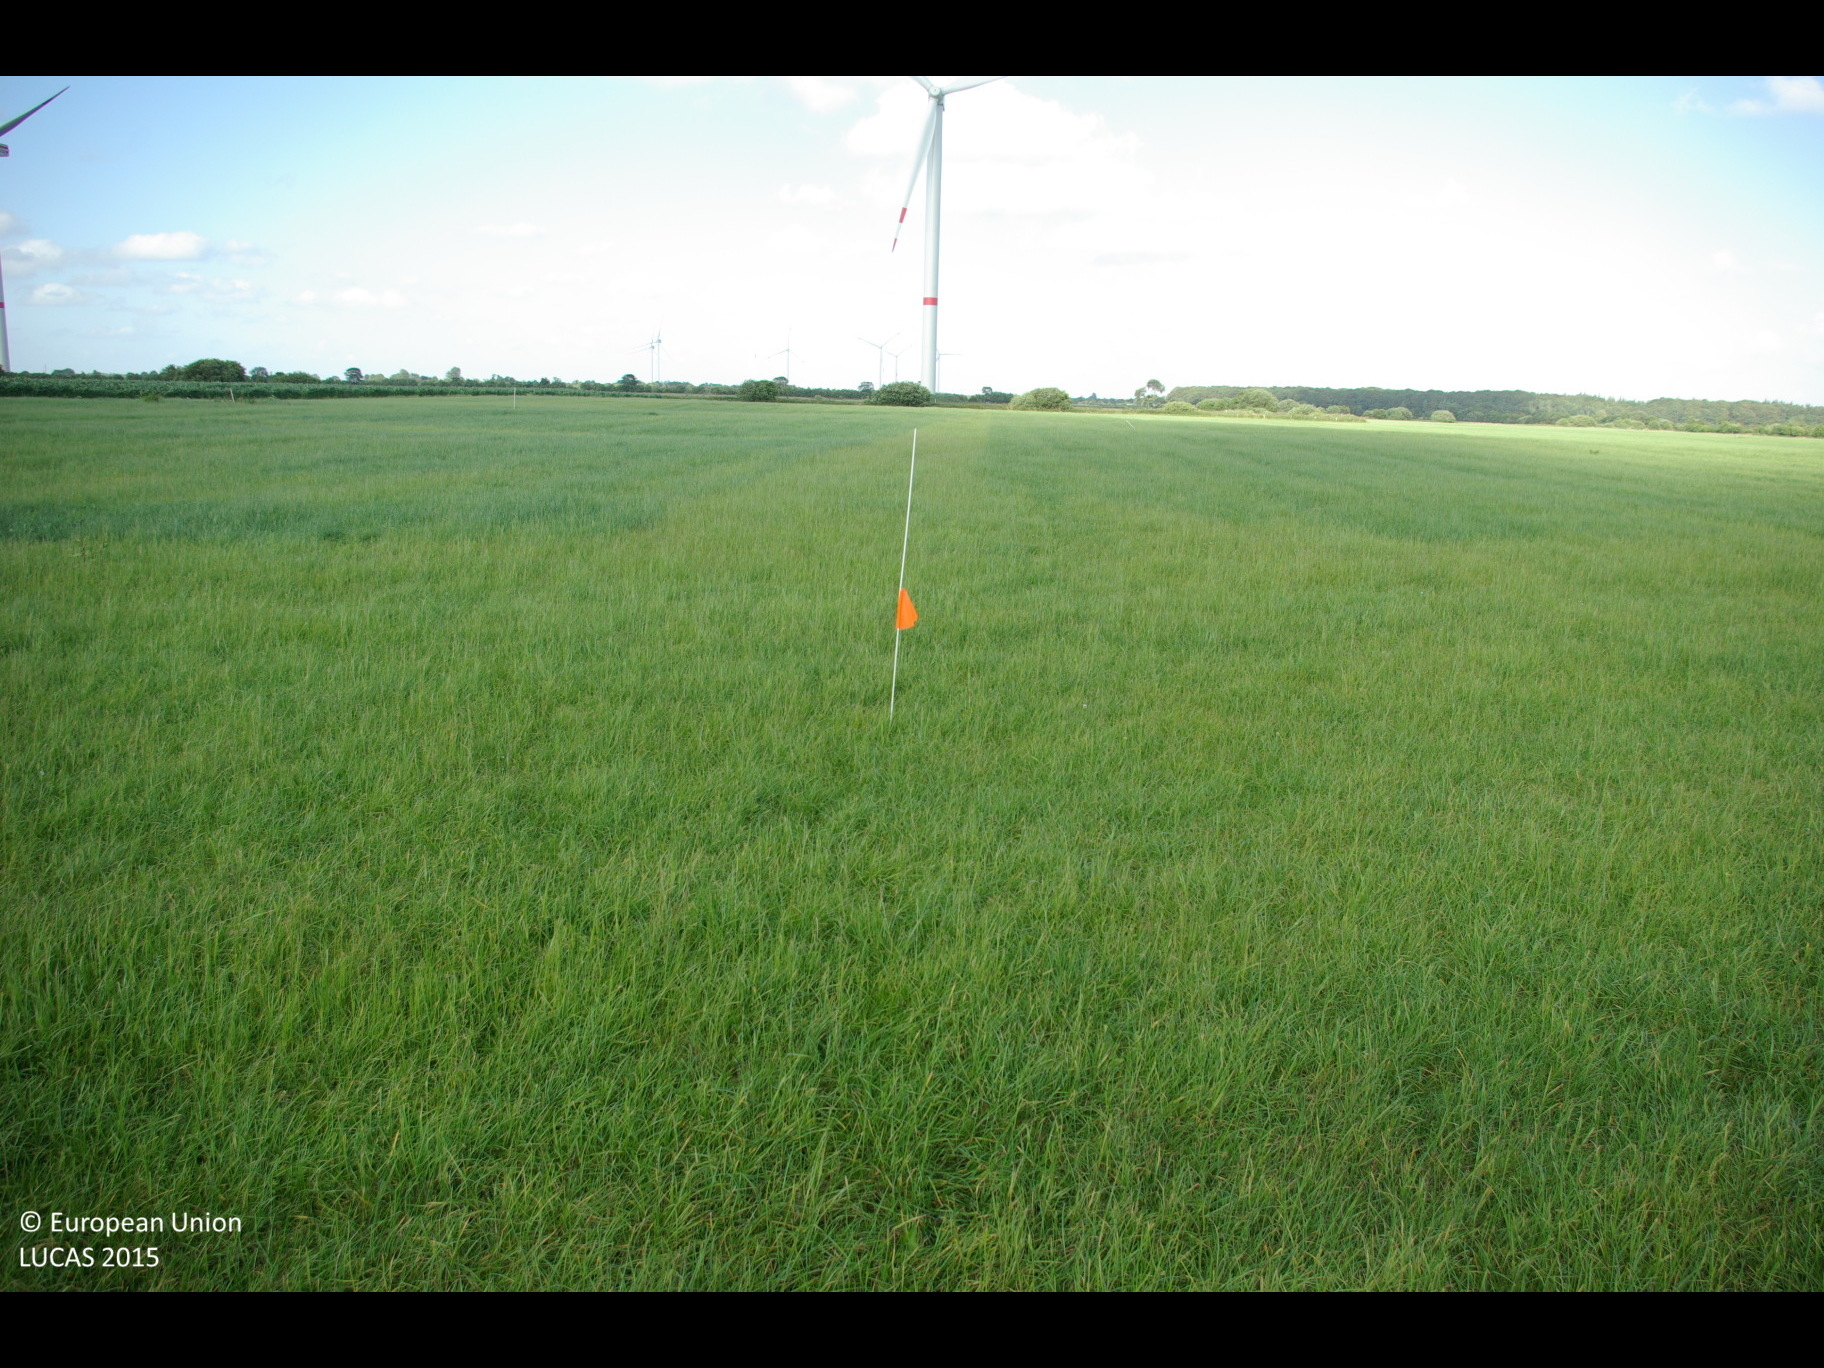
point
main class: Grassland
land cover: Grassland without tree/shrub cover
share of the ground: > 75 %
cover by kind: herbaceous plants 100 %
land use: Agriculture (excluding fallow land and kitchen gardens)
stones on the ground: < 10 %
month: July
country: DE
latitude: 54.6580
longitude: 9.3029
